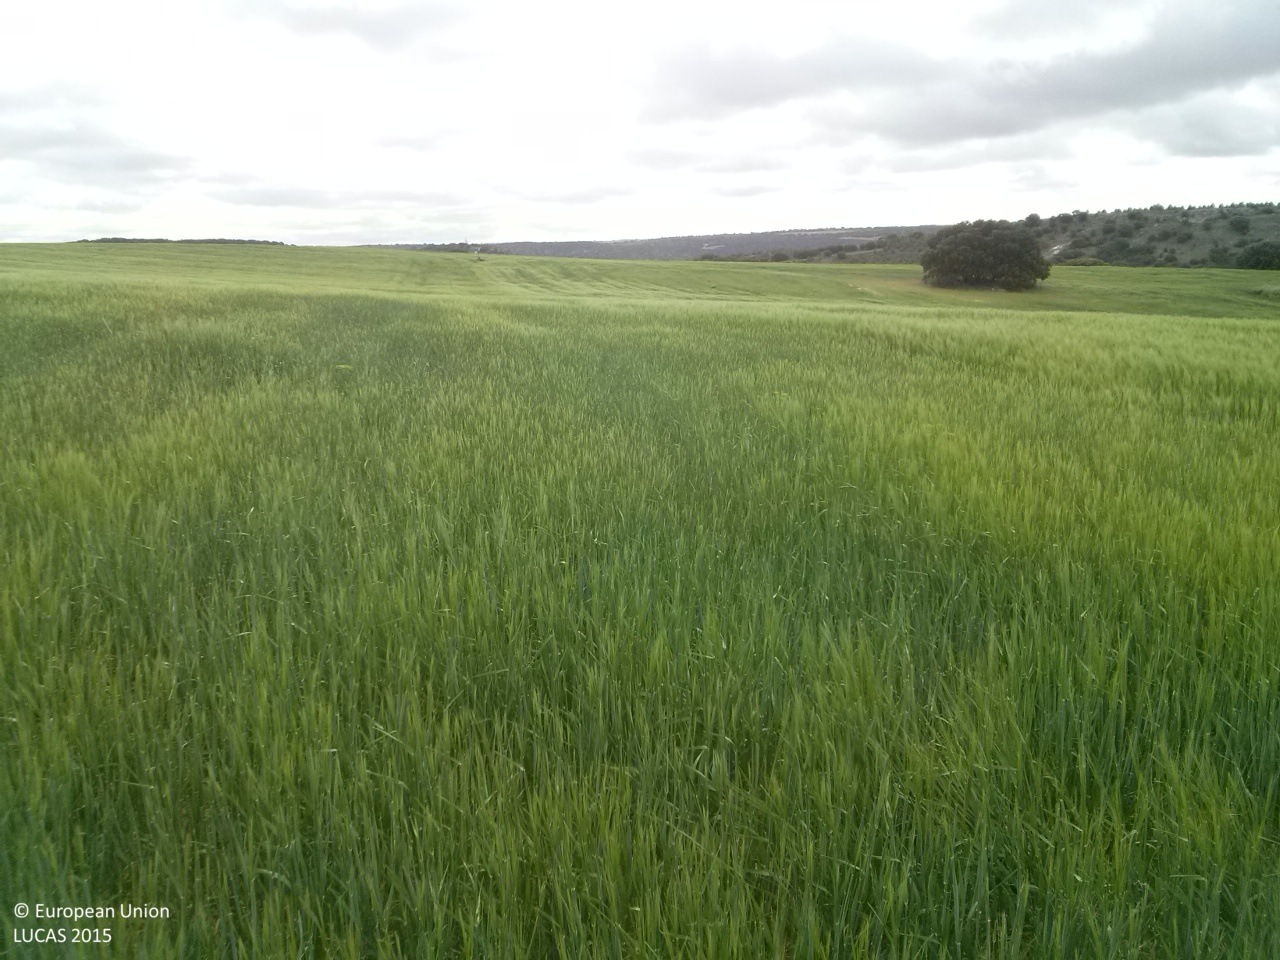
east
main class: Cropland
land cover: Barley
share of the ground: > 75 %
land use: Agriculture (excluding fallow land and kitchen gardens)
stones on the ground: < 10 %
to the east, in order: Barley; Rock outcrops; Barley
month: May
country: ES
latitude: 39.8555
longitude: -2.8661
